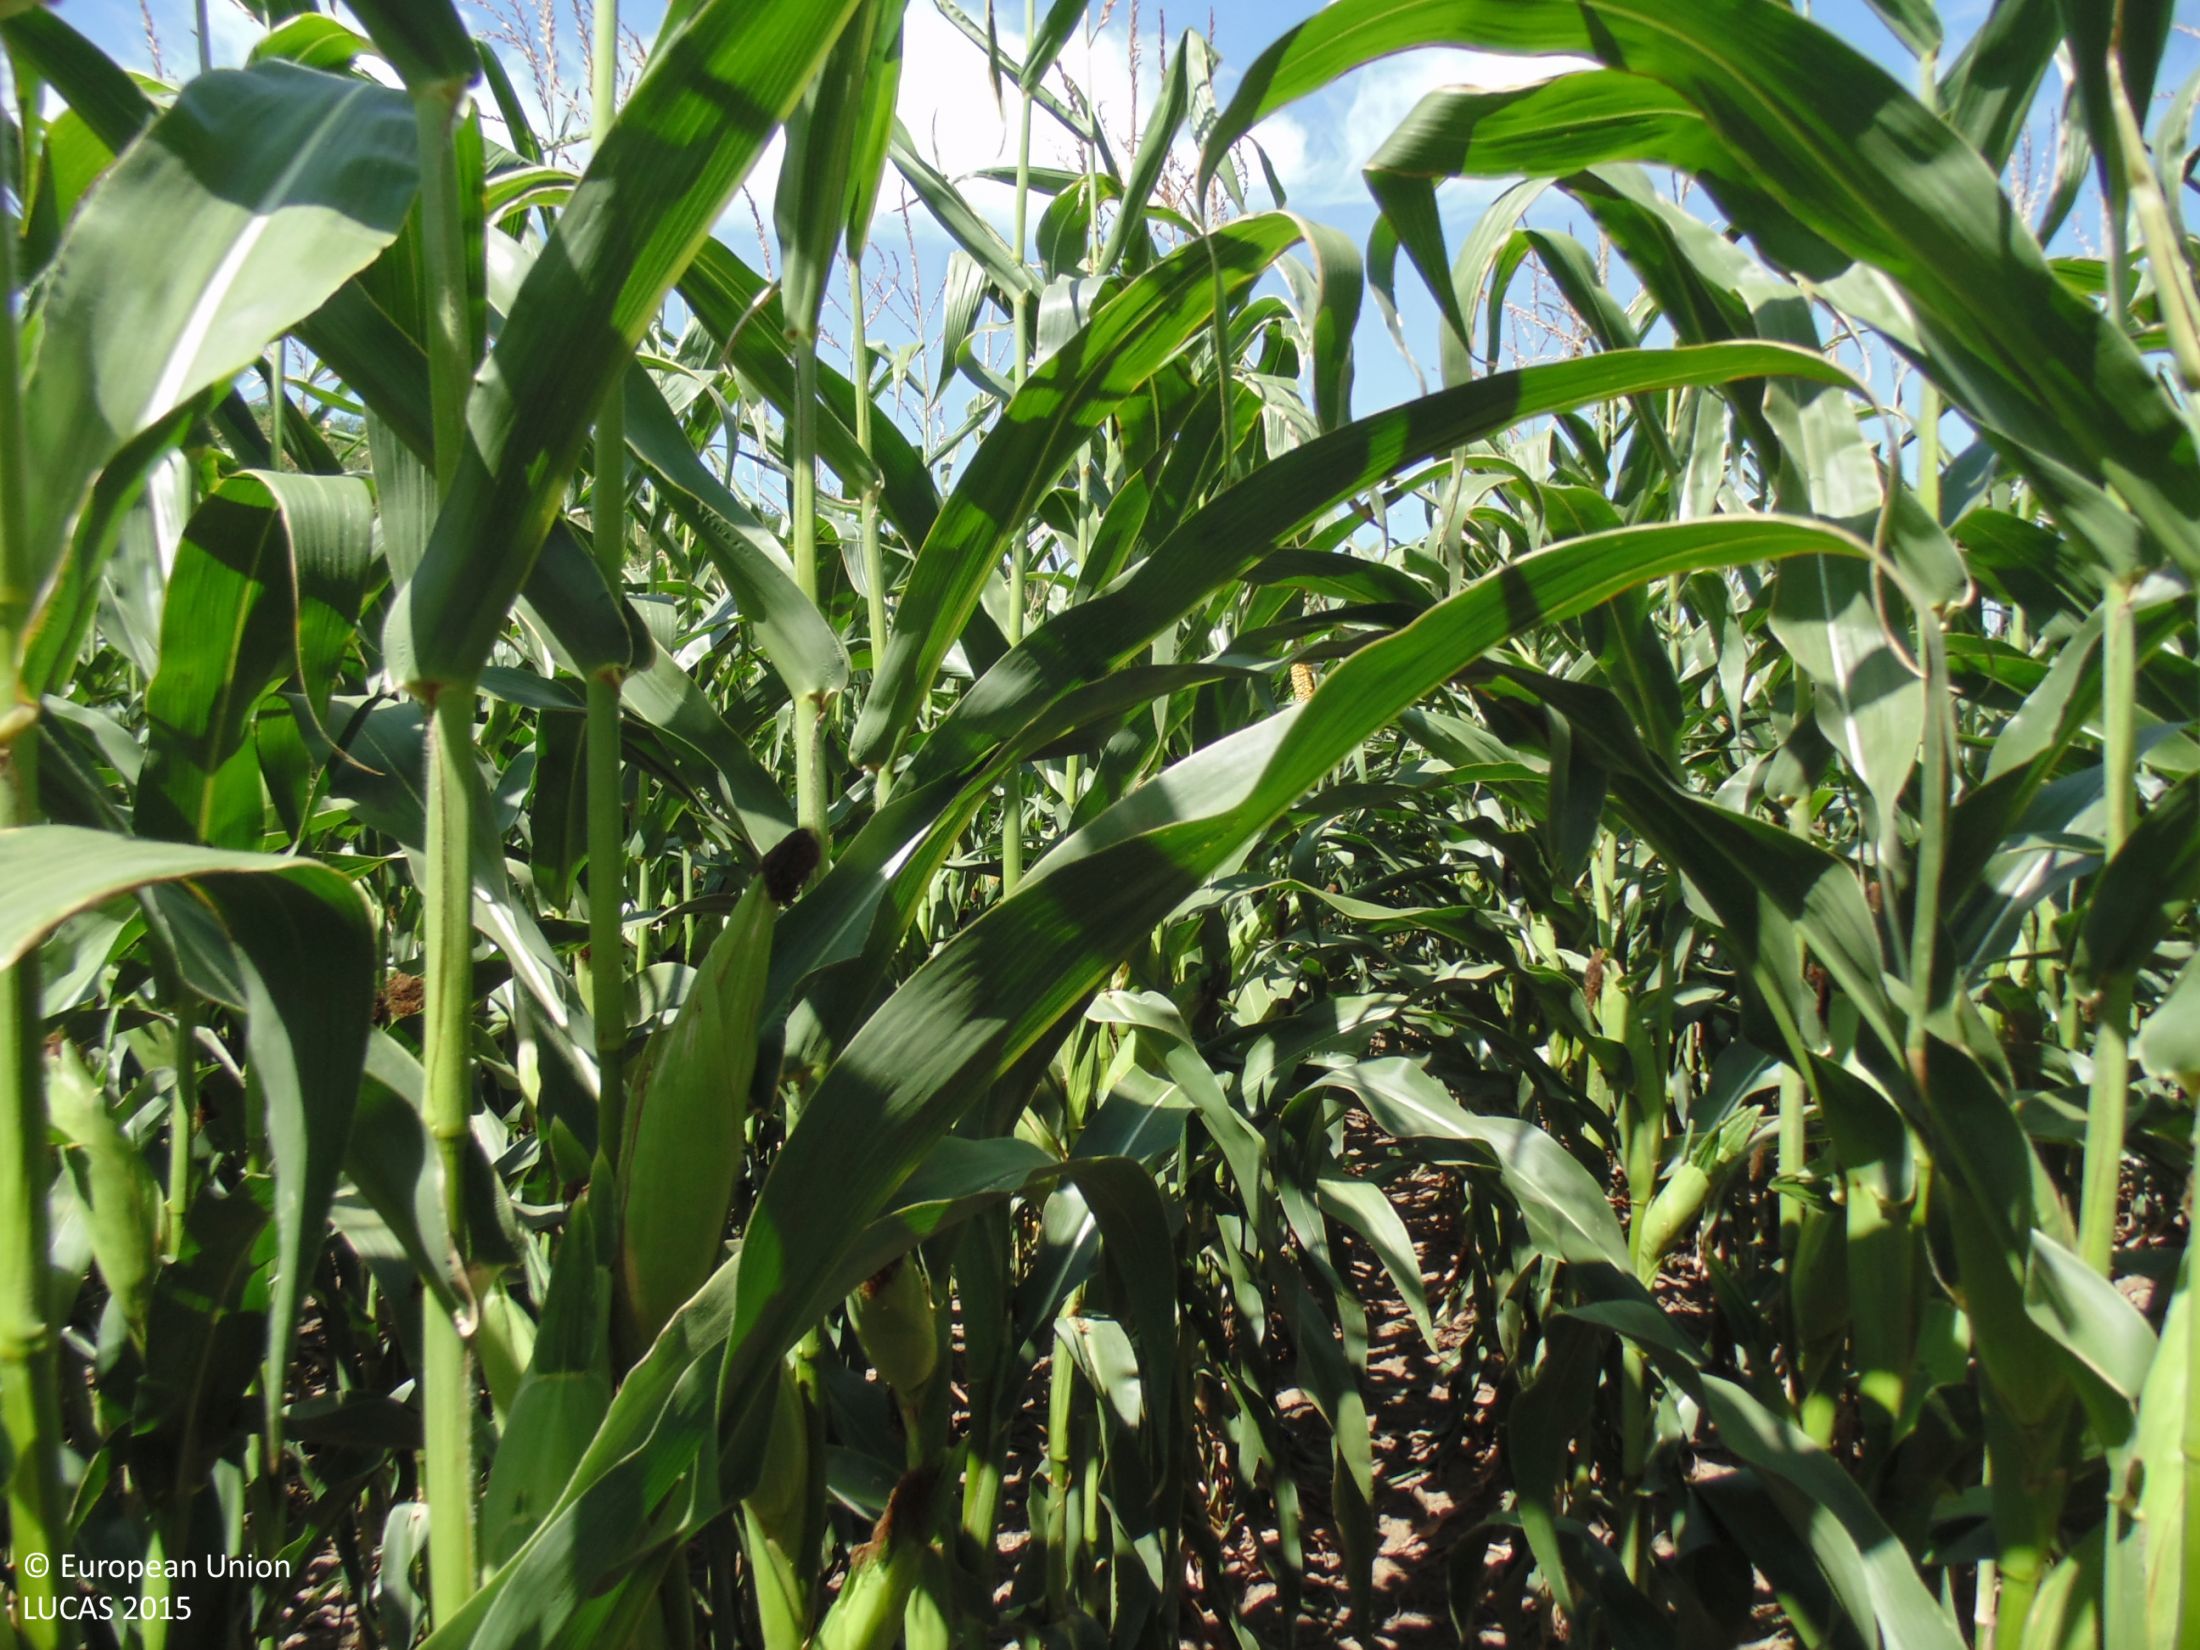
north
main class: Cropland
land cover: Maize
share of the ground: > 75 %
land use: Agriculture (excluding fallow land and kitchen gardens)
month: August
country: BG
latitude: 43.8216
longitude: 27.7355
